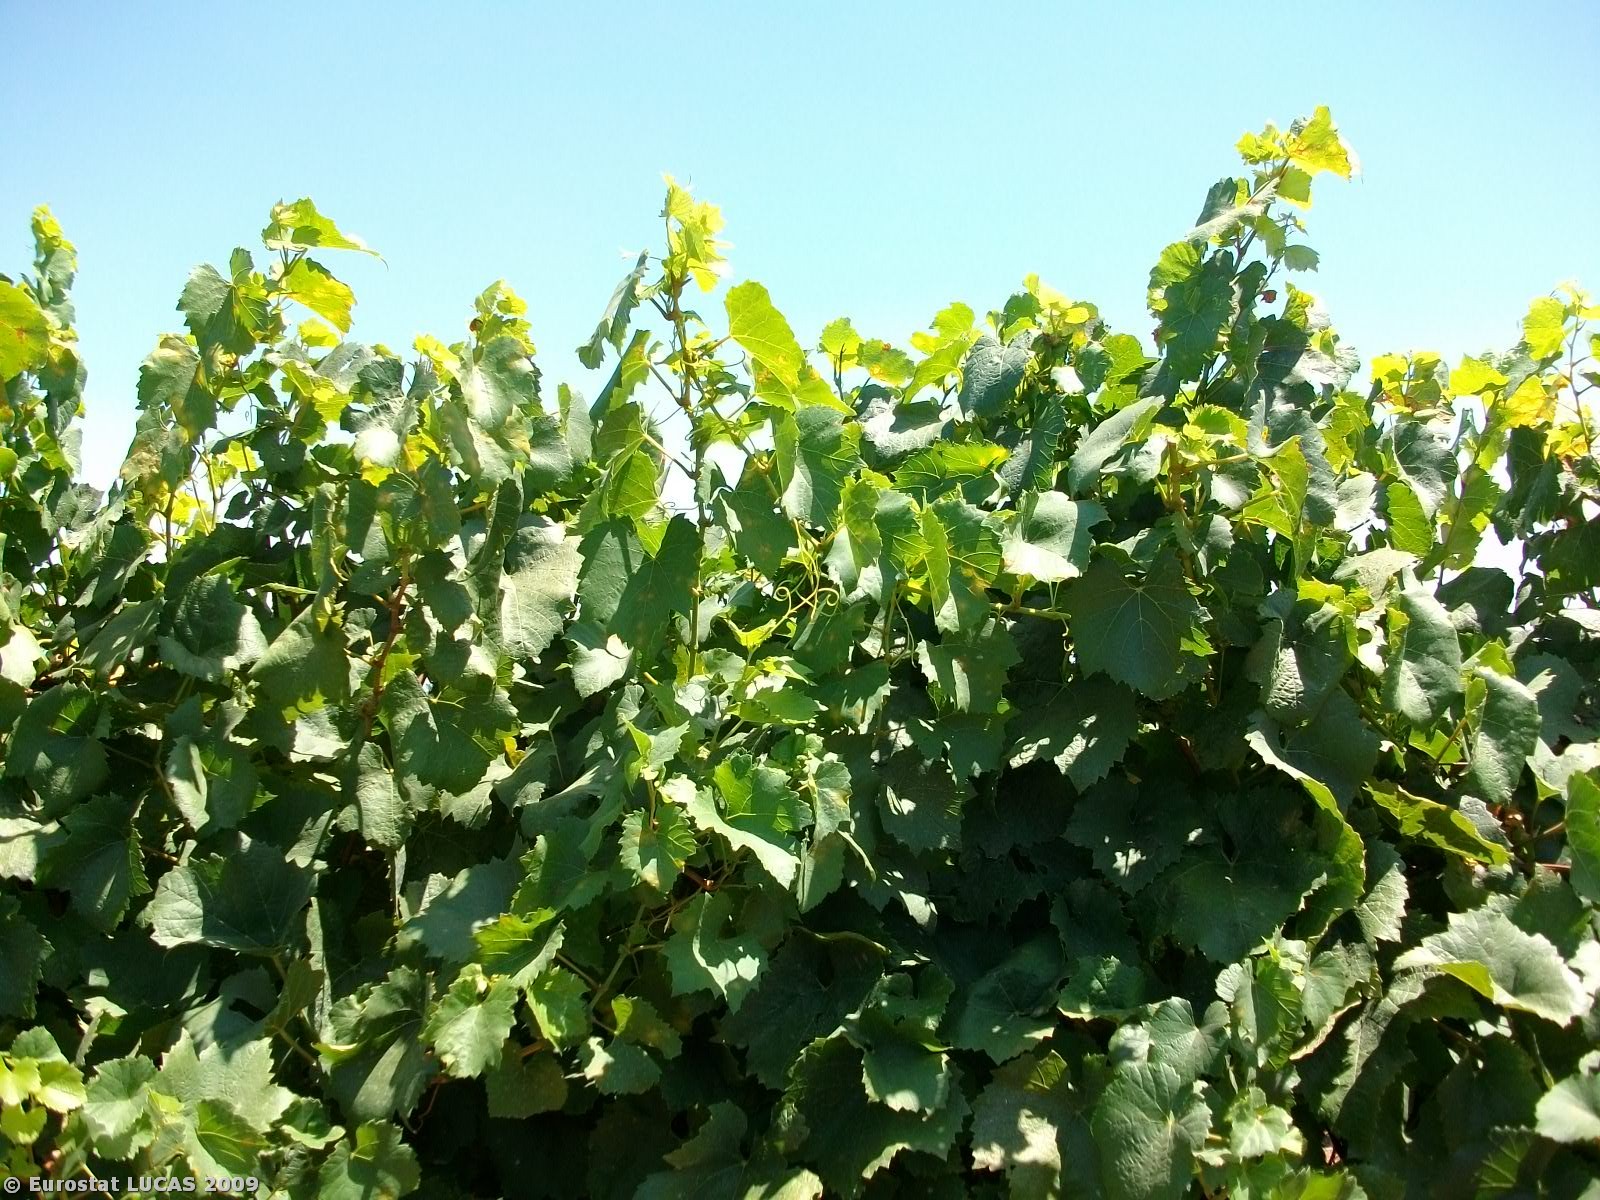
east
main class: Cropland
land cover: Vineyards
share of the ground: 50 - 75 %
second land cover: Bare land
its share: 50 - 75 %
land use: Agriculture (excluding fallow land and kitchen gardens)
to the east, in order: Vineyards; Bare land; Grassland with sparse tree/shrub cover; Electric lines; Grassland with sparse tree/shrub cover; Tracks; Grassland with sparse tree/shrub cover; Paved roads, cycling and walking lanes; Abandoned hedges; Tracks; Inland marshes
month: July
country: GR
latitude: 37.9175
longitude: 21.4164
